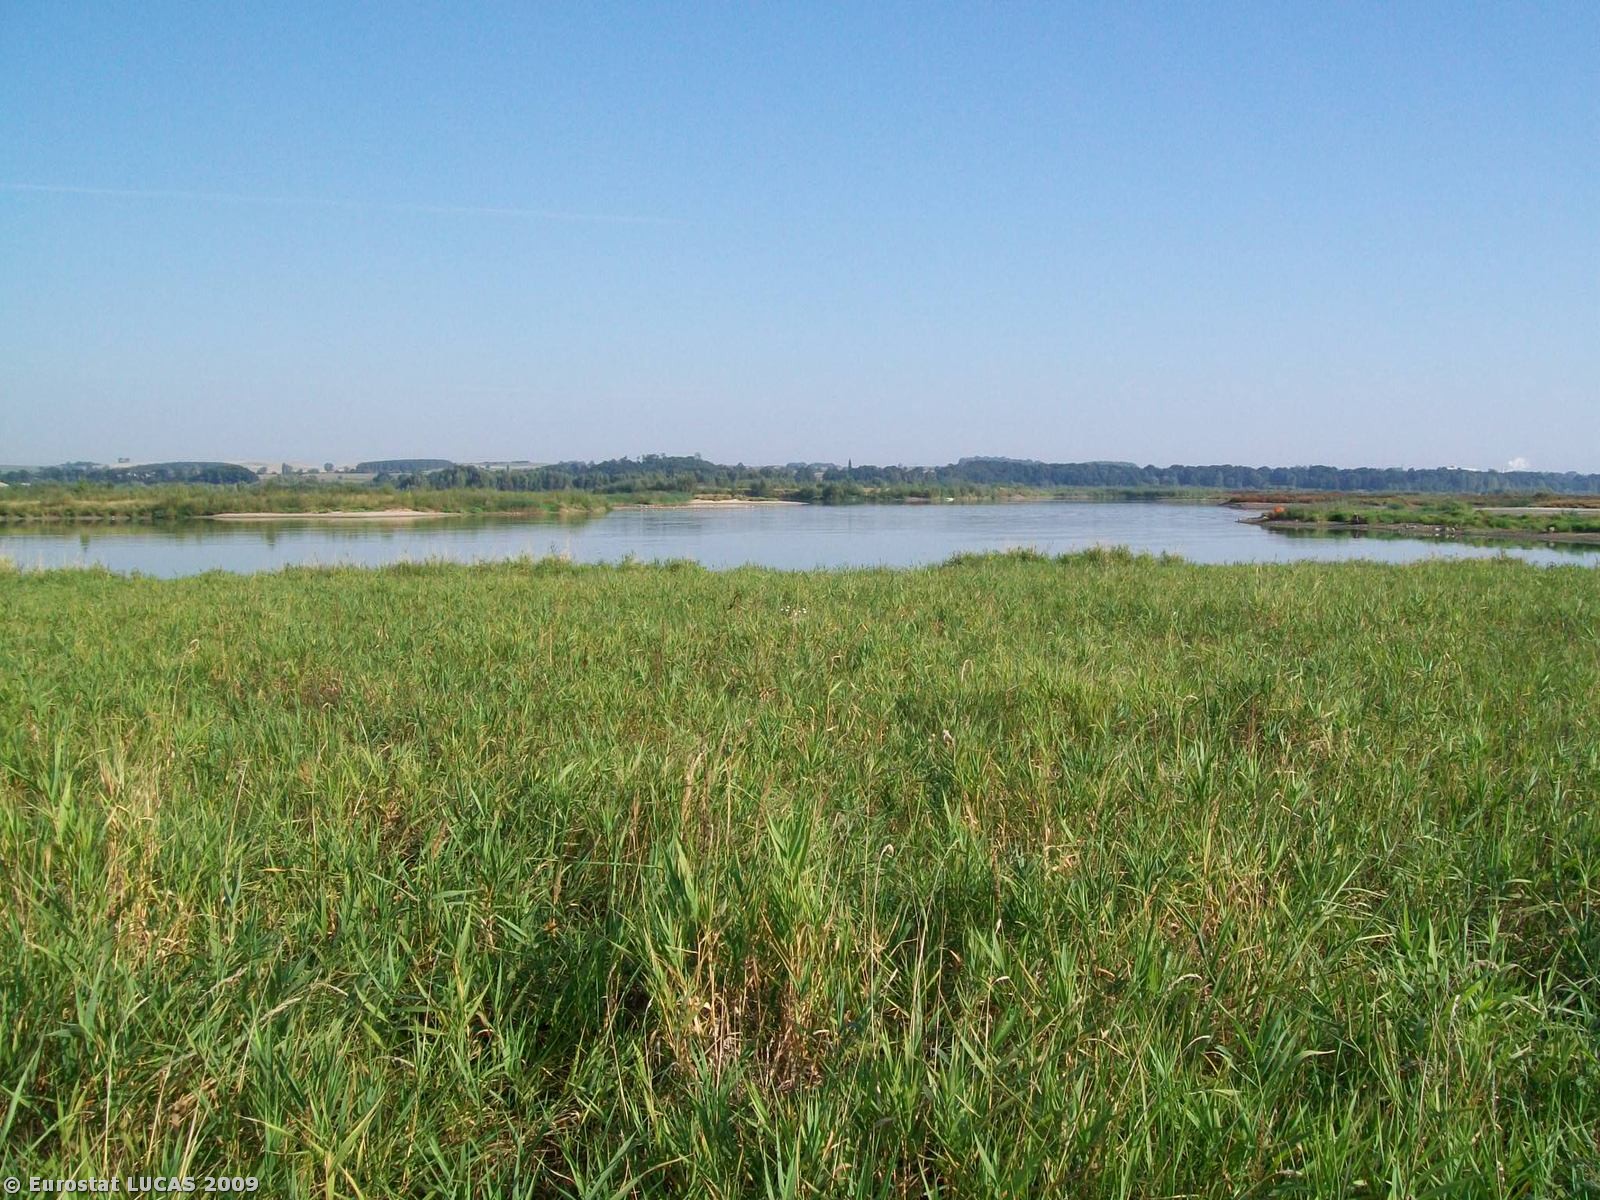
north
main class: Grassland
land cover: Grassland without tree/shrub cover
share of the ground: > 75 %
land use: Unused
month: September
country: PL
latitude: 50.4418
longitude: 17.2347
